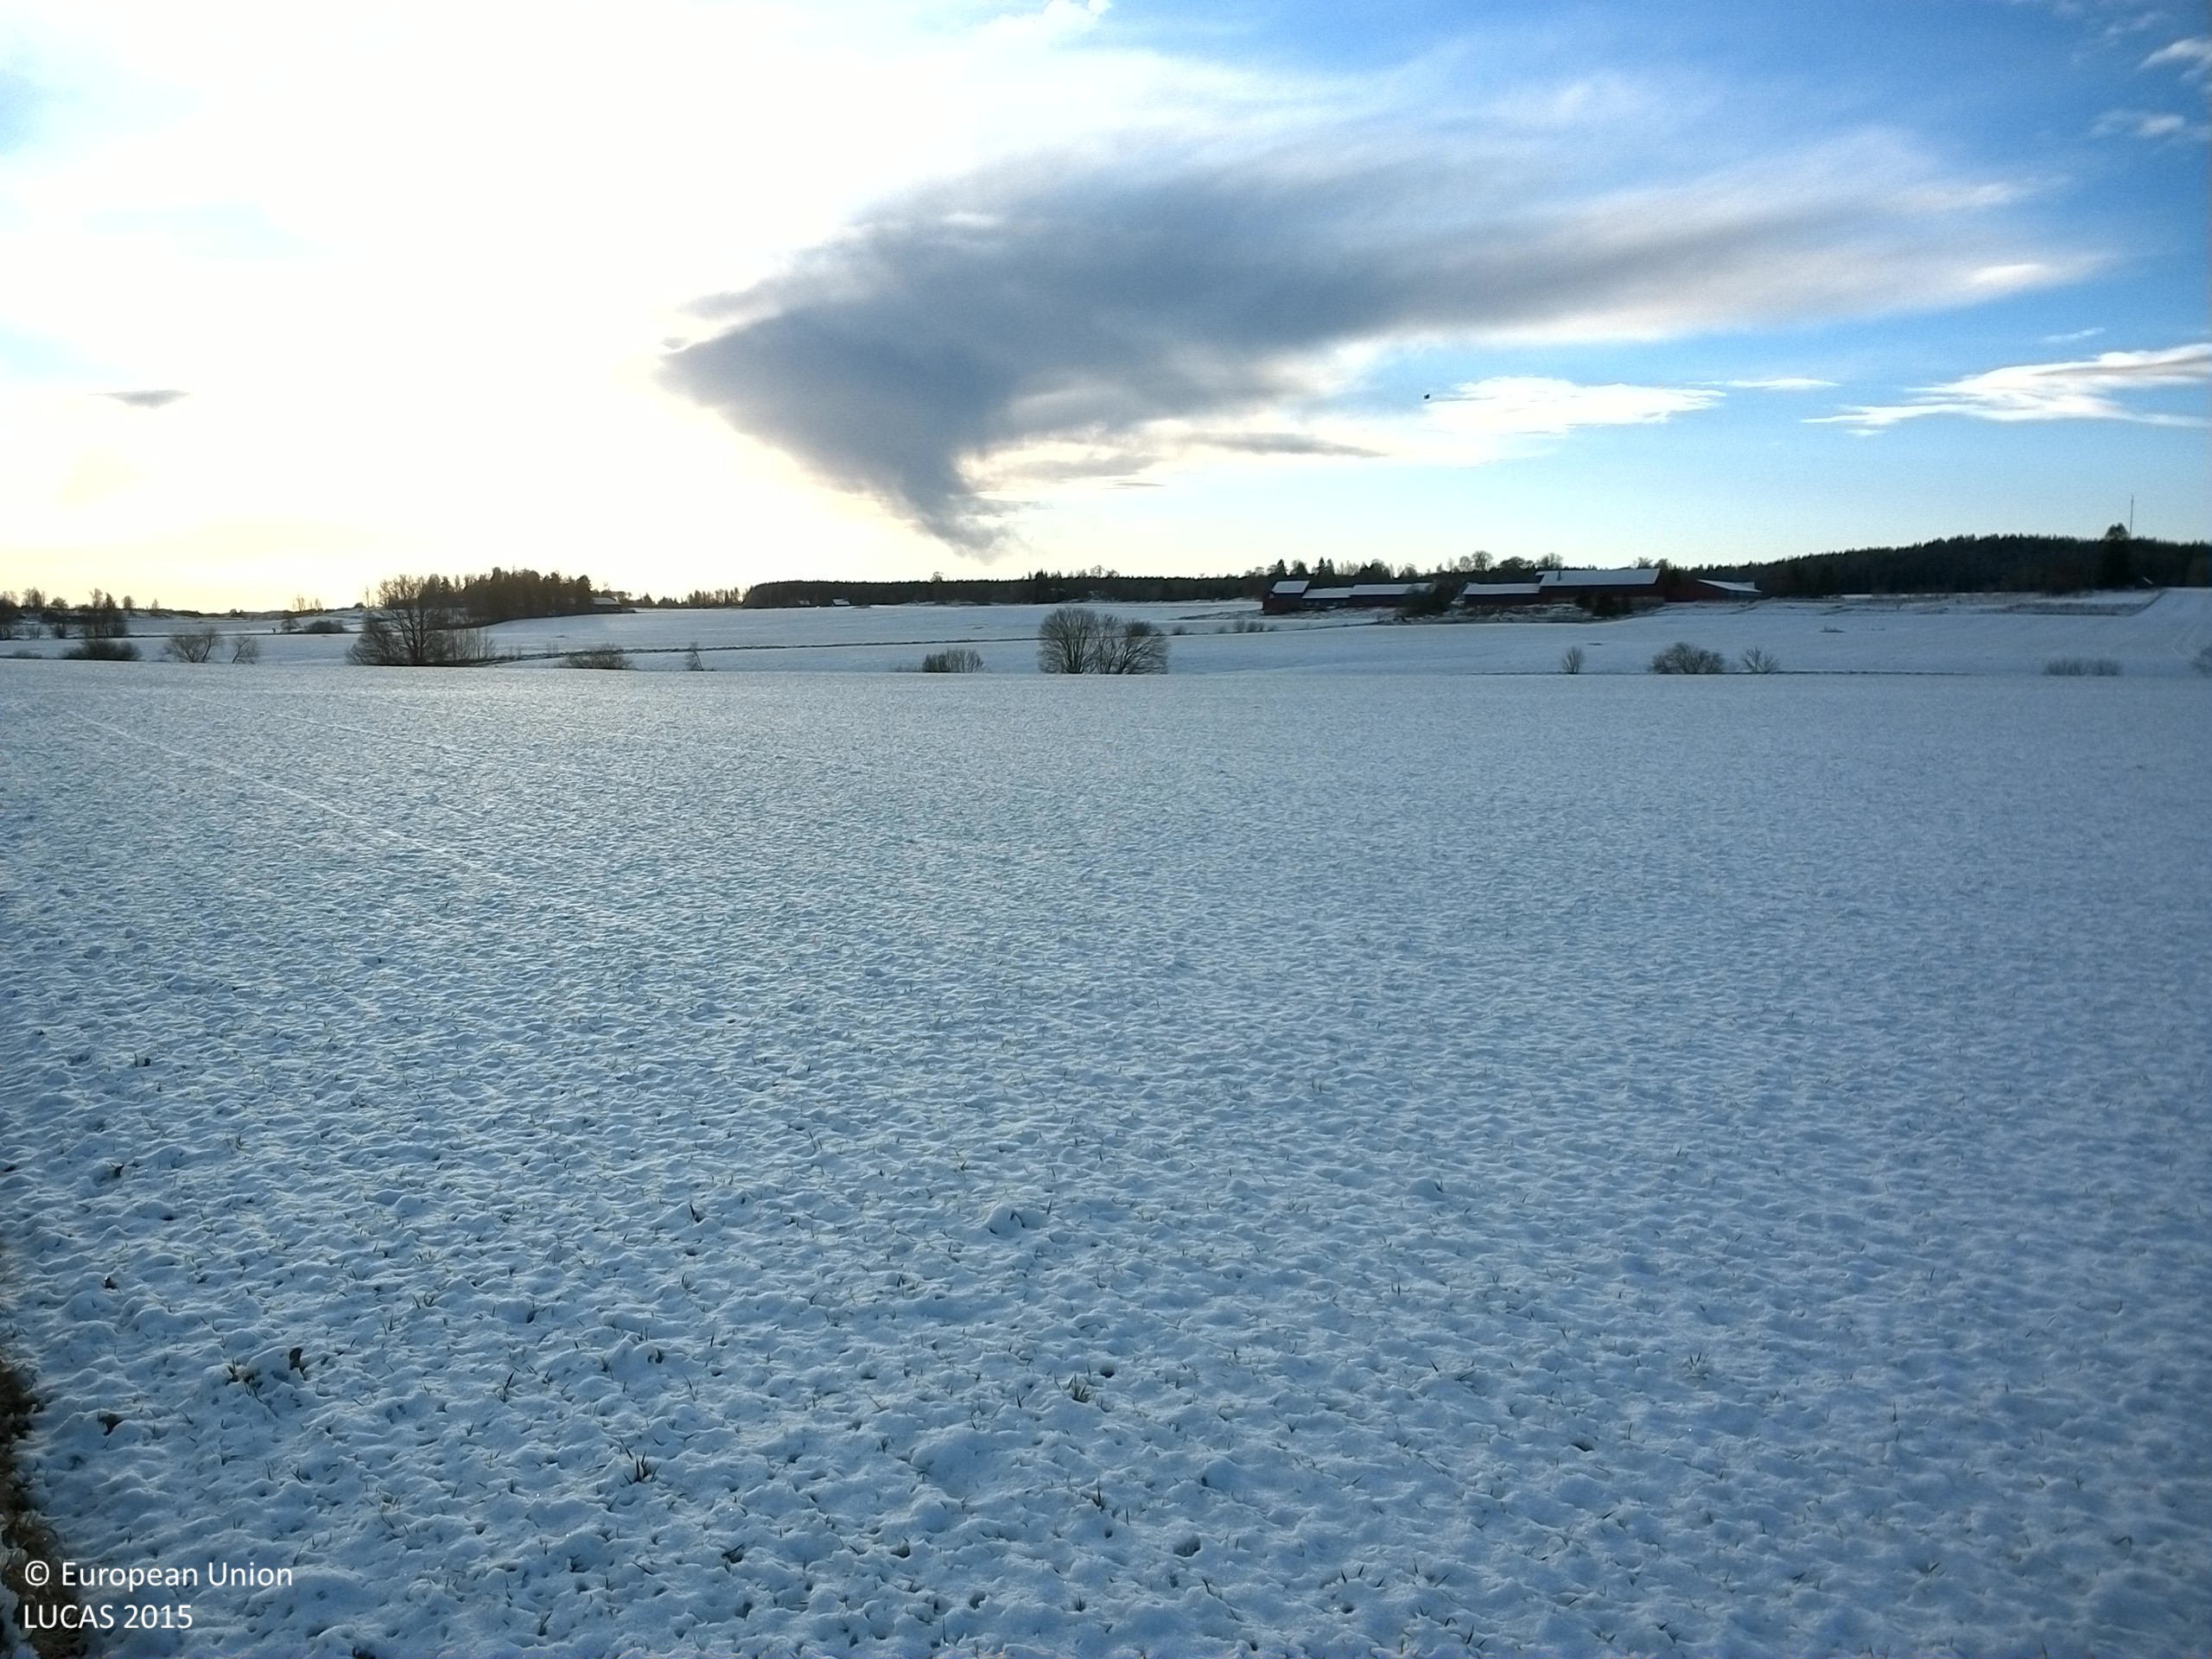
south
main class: Cropland
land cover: Common wheat
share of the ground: 10 - 25 %
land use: Agriculture (excluding fallow land and kitchen gardens)
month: December
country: SE
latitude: 59.6903
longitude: 16.4401
